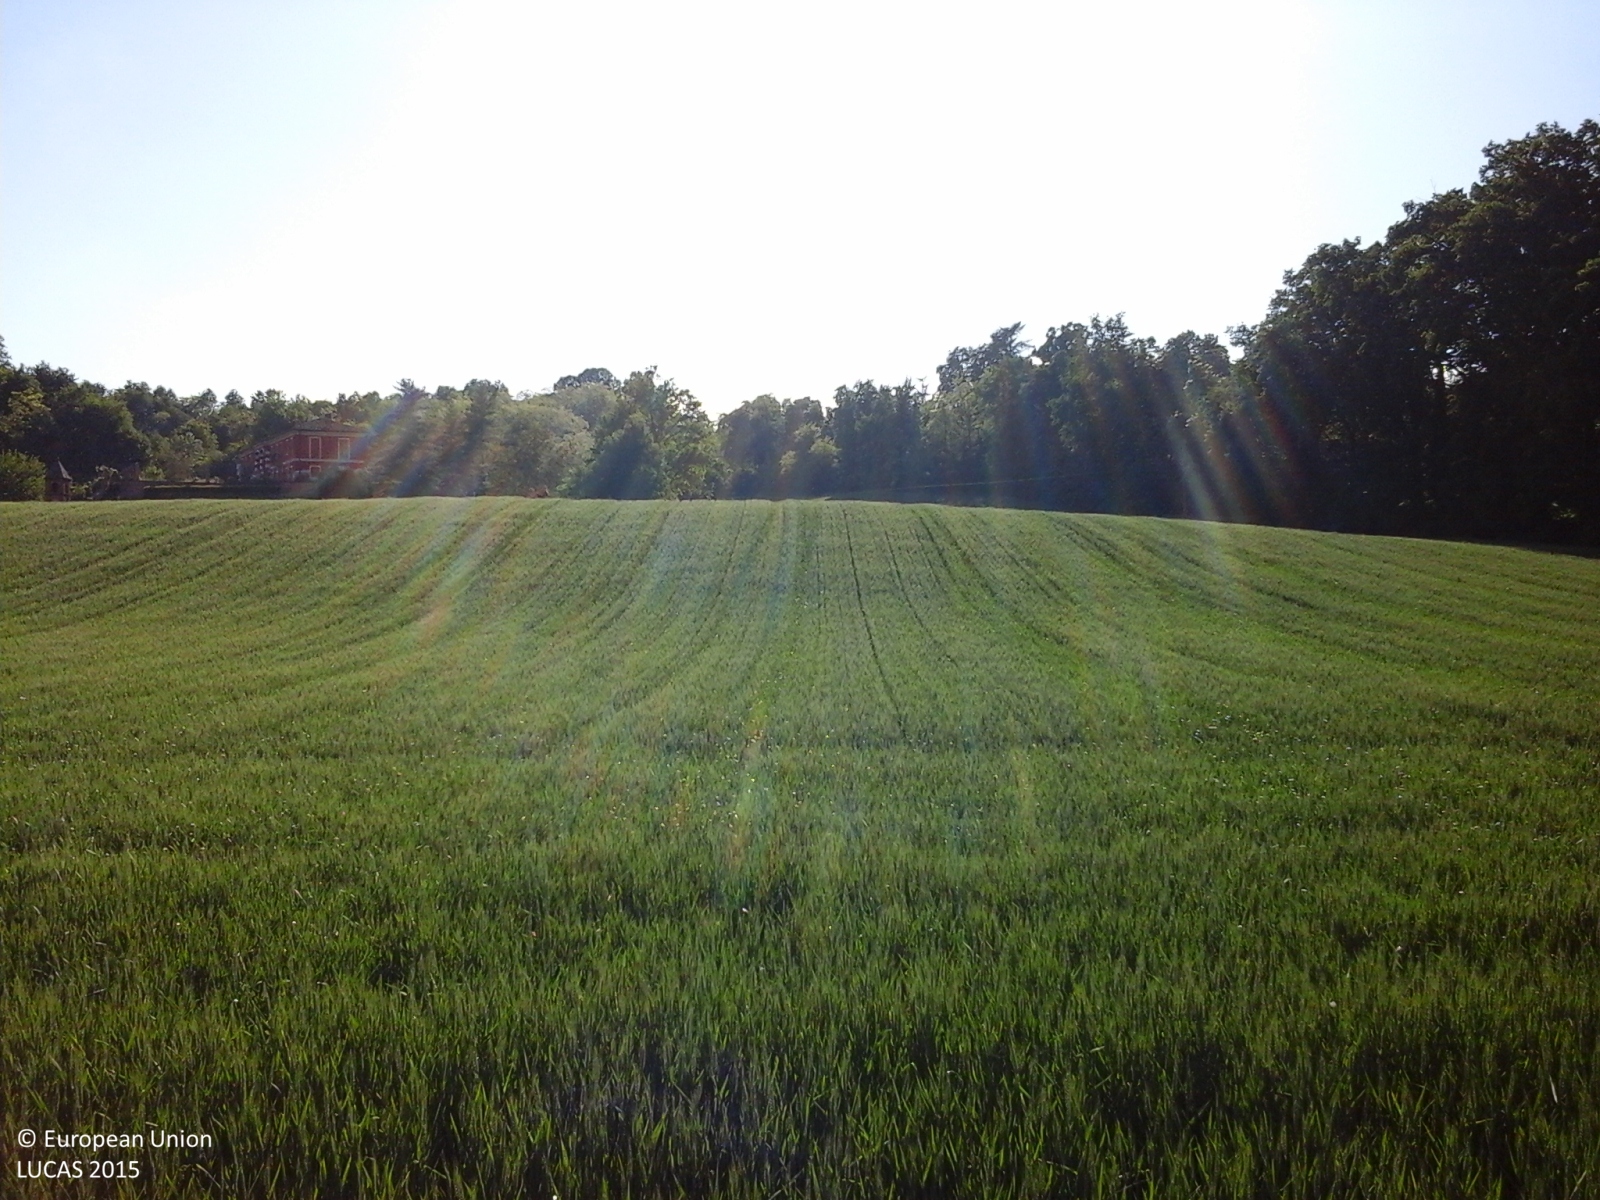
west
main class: Cropland
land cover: Common wheat
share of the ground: > 75 %
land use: Agriculture (excluding fallow land and kitchen gardens)
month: May
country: IT
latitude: 44.9305
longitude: 8.2168
